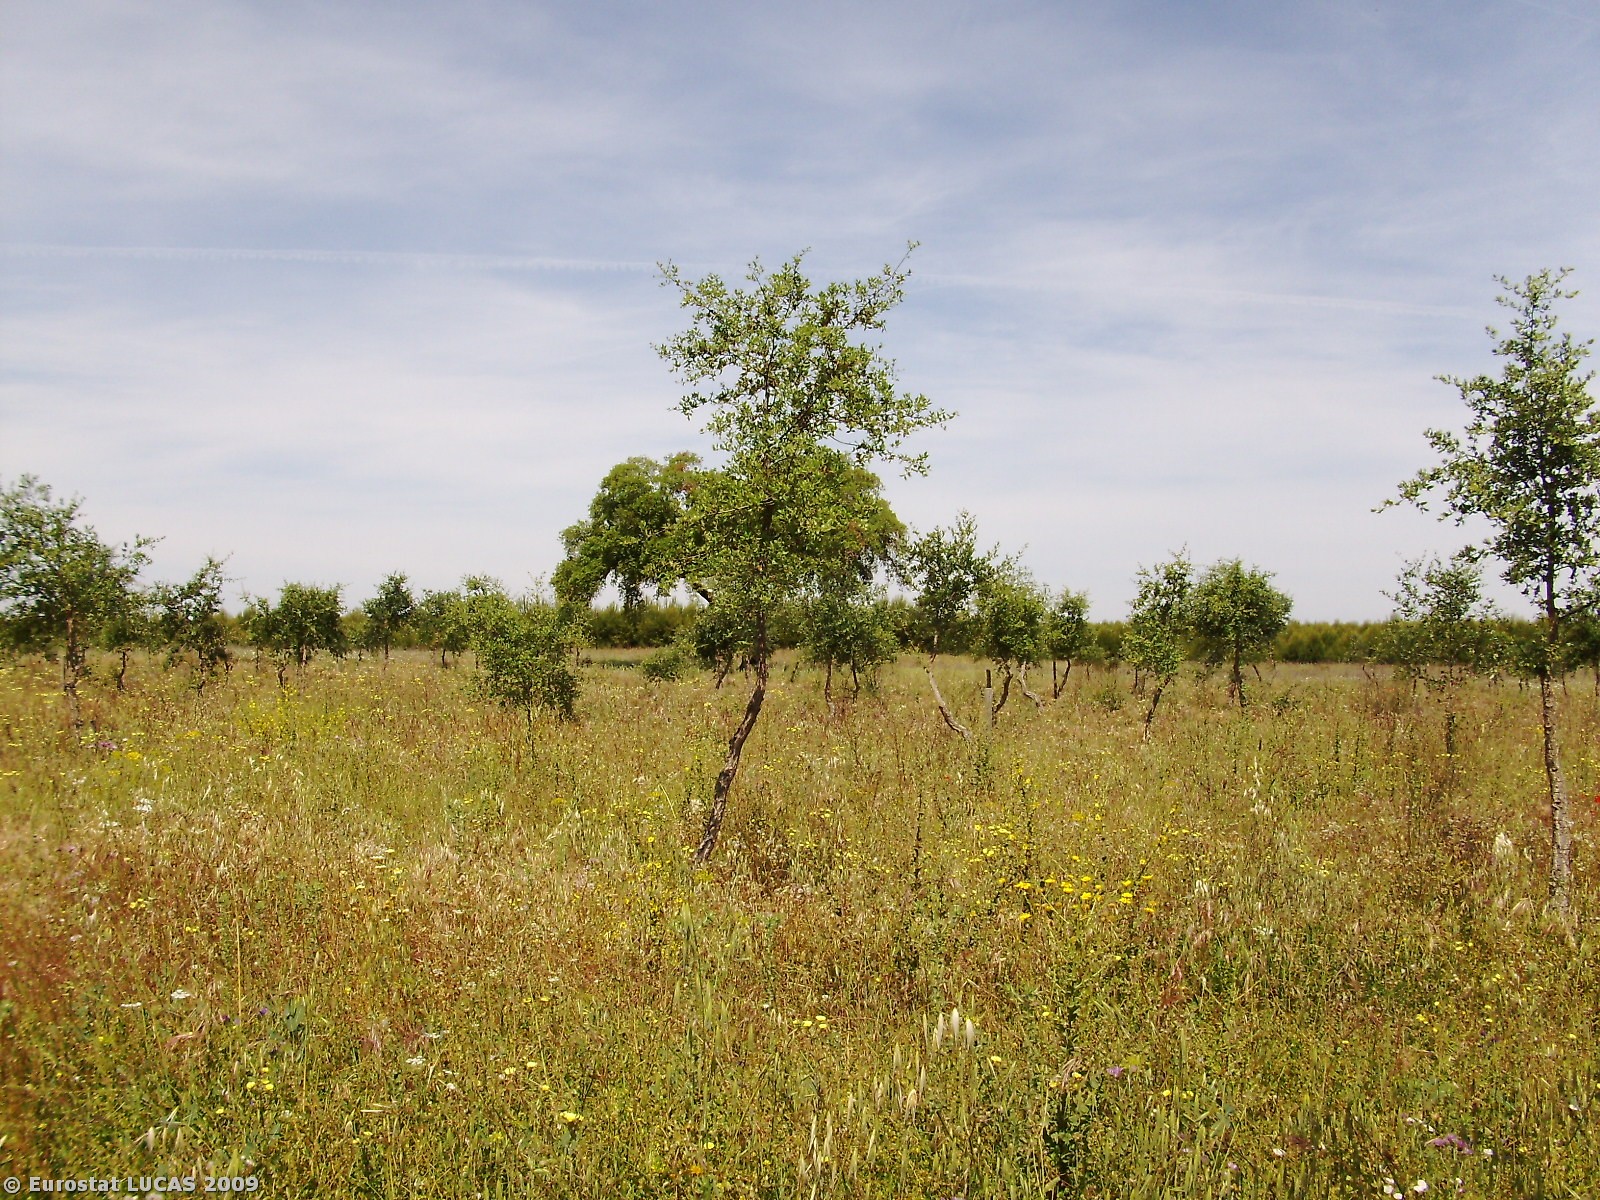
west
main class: Woodland
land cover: Broadleaved woodland
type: broadleaved evergreen forest
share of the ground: 25 - 50 %
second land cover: Spontaneously vegetated surfaces
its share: 50 - 75 %
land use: Forestry
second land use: Fallow land
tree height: > 5 m
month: May
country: PT
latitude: 39.0372
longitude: -8.0629
